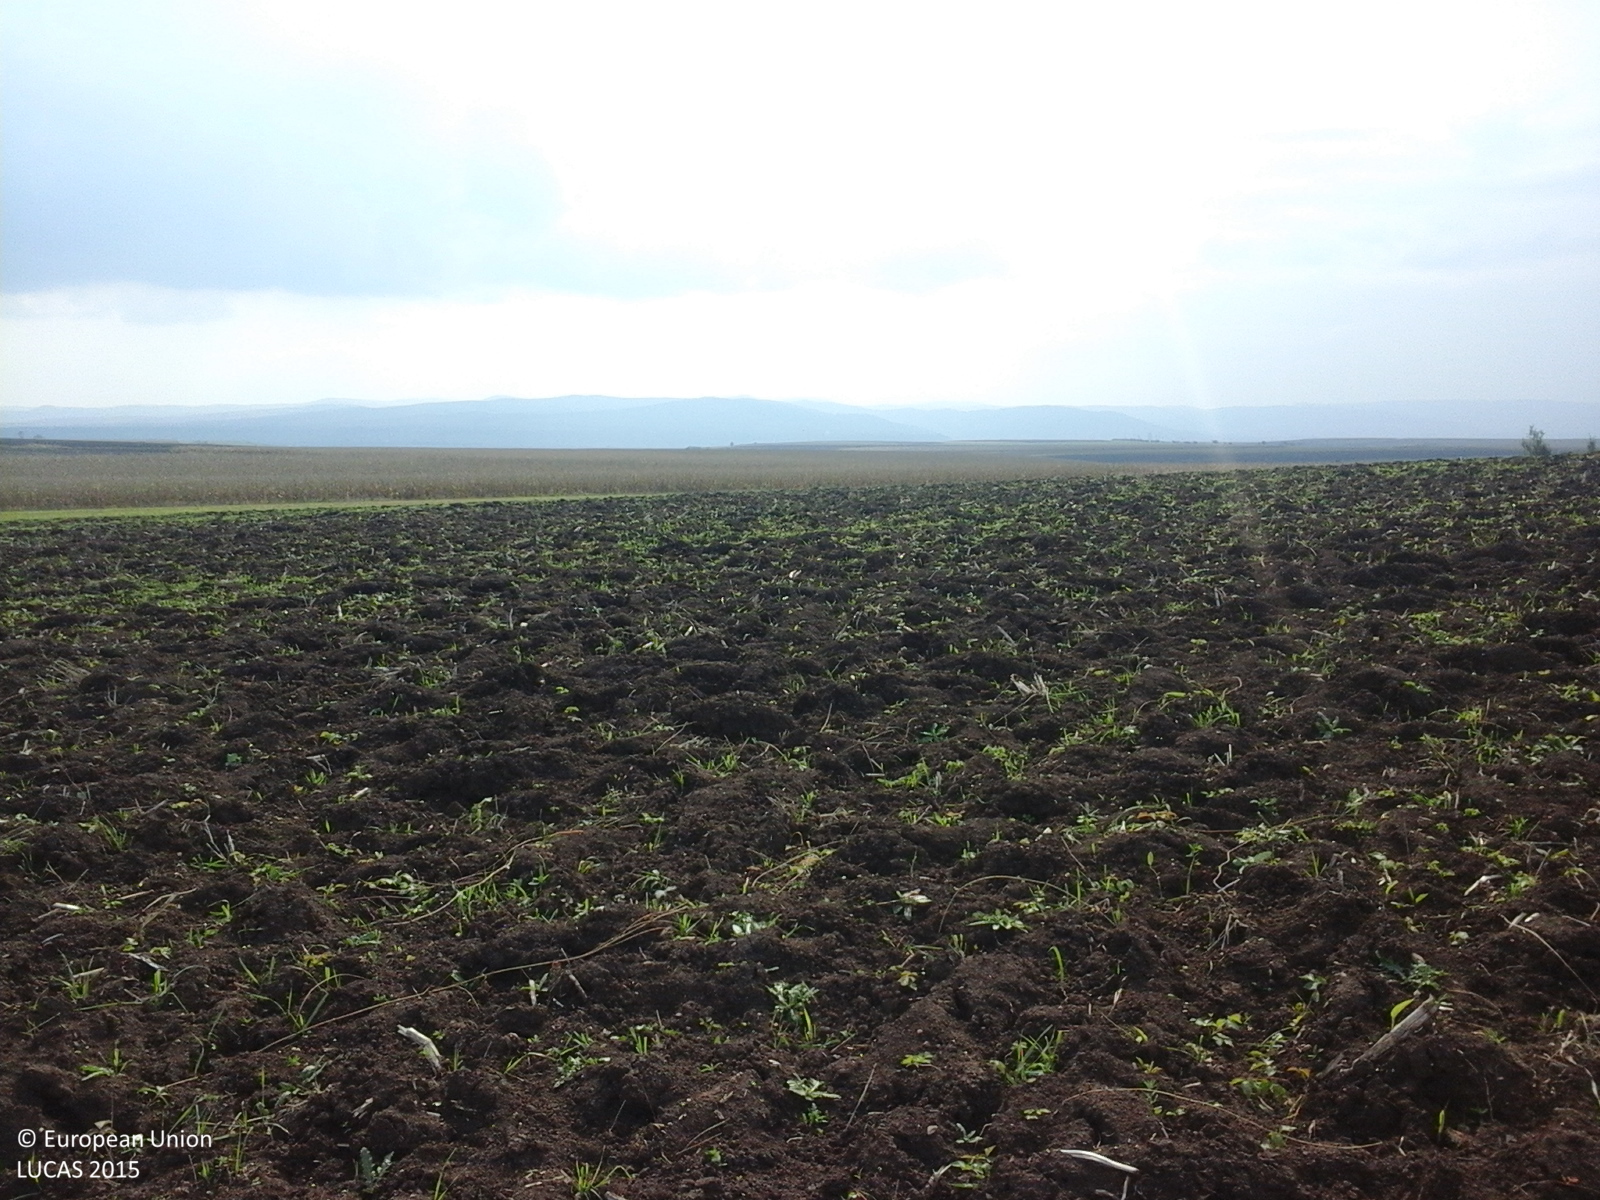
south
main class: Cropland
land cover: Maize
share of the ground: < 10 %
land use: Agriculture (excluding fallow land and kitchen gardens)
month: October
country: RO
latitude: 46.4447
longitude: 23.8855
